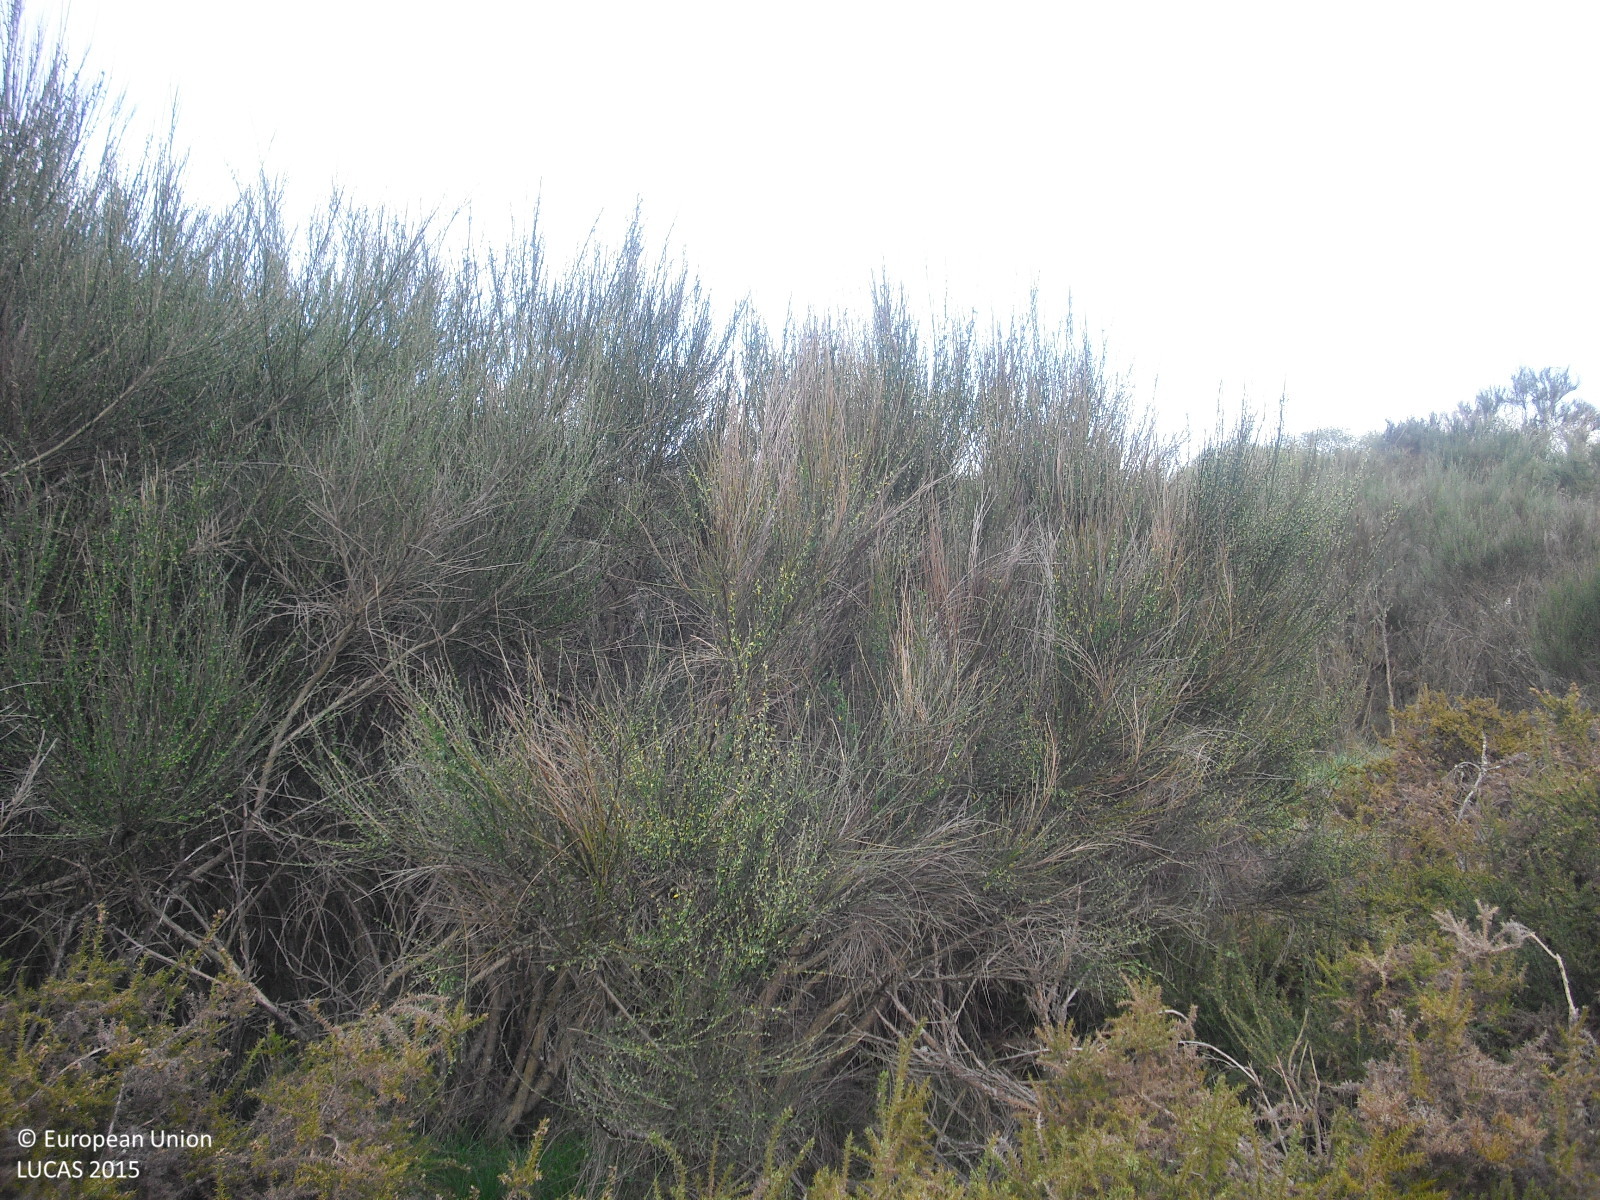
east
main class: Shrubland
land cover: Shrubland with sparse tree cover
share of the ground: > 75 %
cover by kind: shrubs 95 %, broadleaved forest trees 5 %
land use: Abandoned areas
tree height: < 5 m
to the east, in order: Shrubland with sparse tree cover; Shrubland without tree cover; Shrubland with sparse tree cover; Ditches and canals; Grass margins; Tracks; Grass margins; Ditches and canals; Broadleaved woodland; Grassland with sparse tree/shrub cover; Shrubland without tree cover
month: April
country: ES
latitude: 41.9006
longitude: -7.6520
